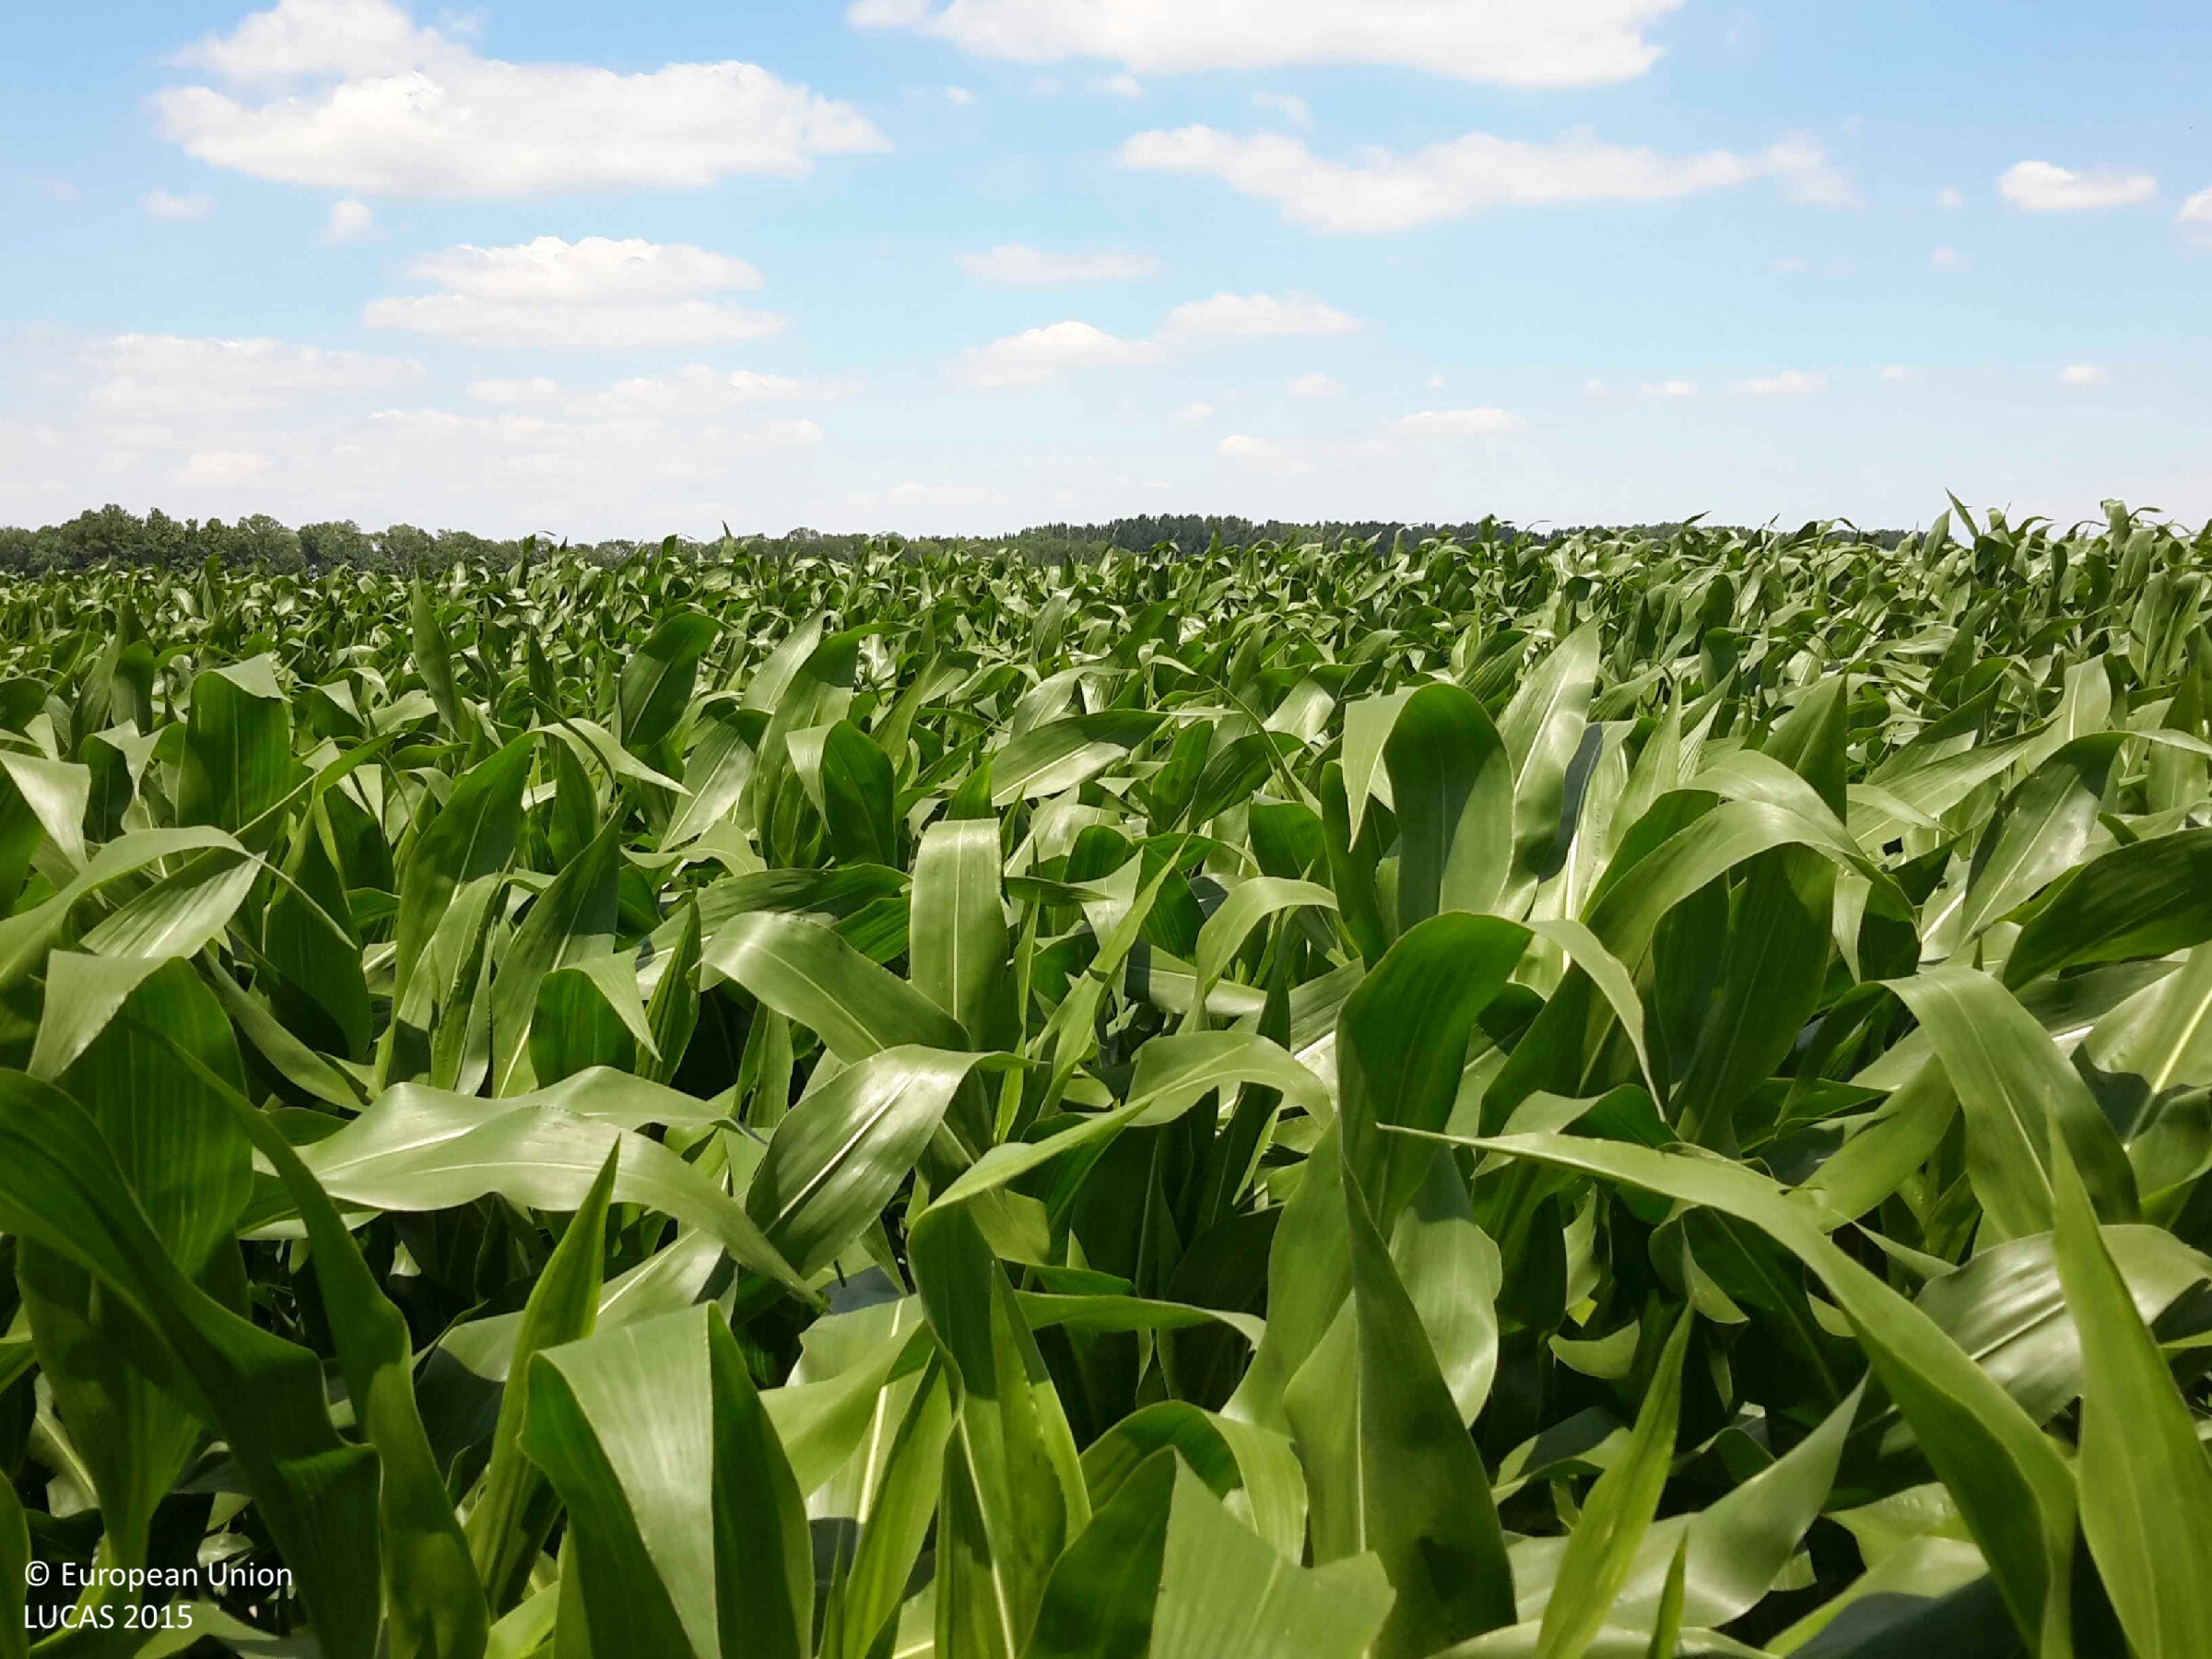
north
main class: Cropland
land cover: Maize
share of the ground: > 75 %
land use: Agriculture (excluding fallow land and kitchen gardens)
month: June
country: HU
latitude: 47.7140
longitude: 17.5131
